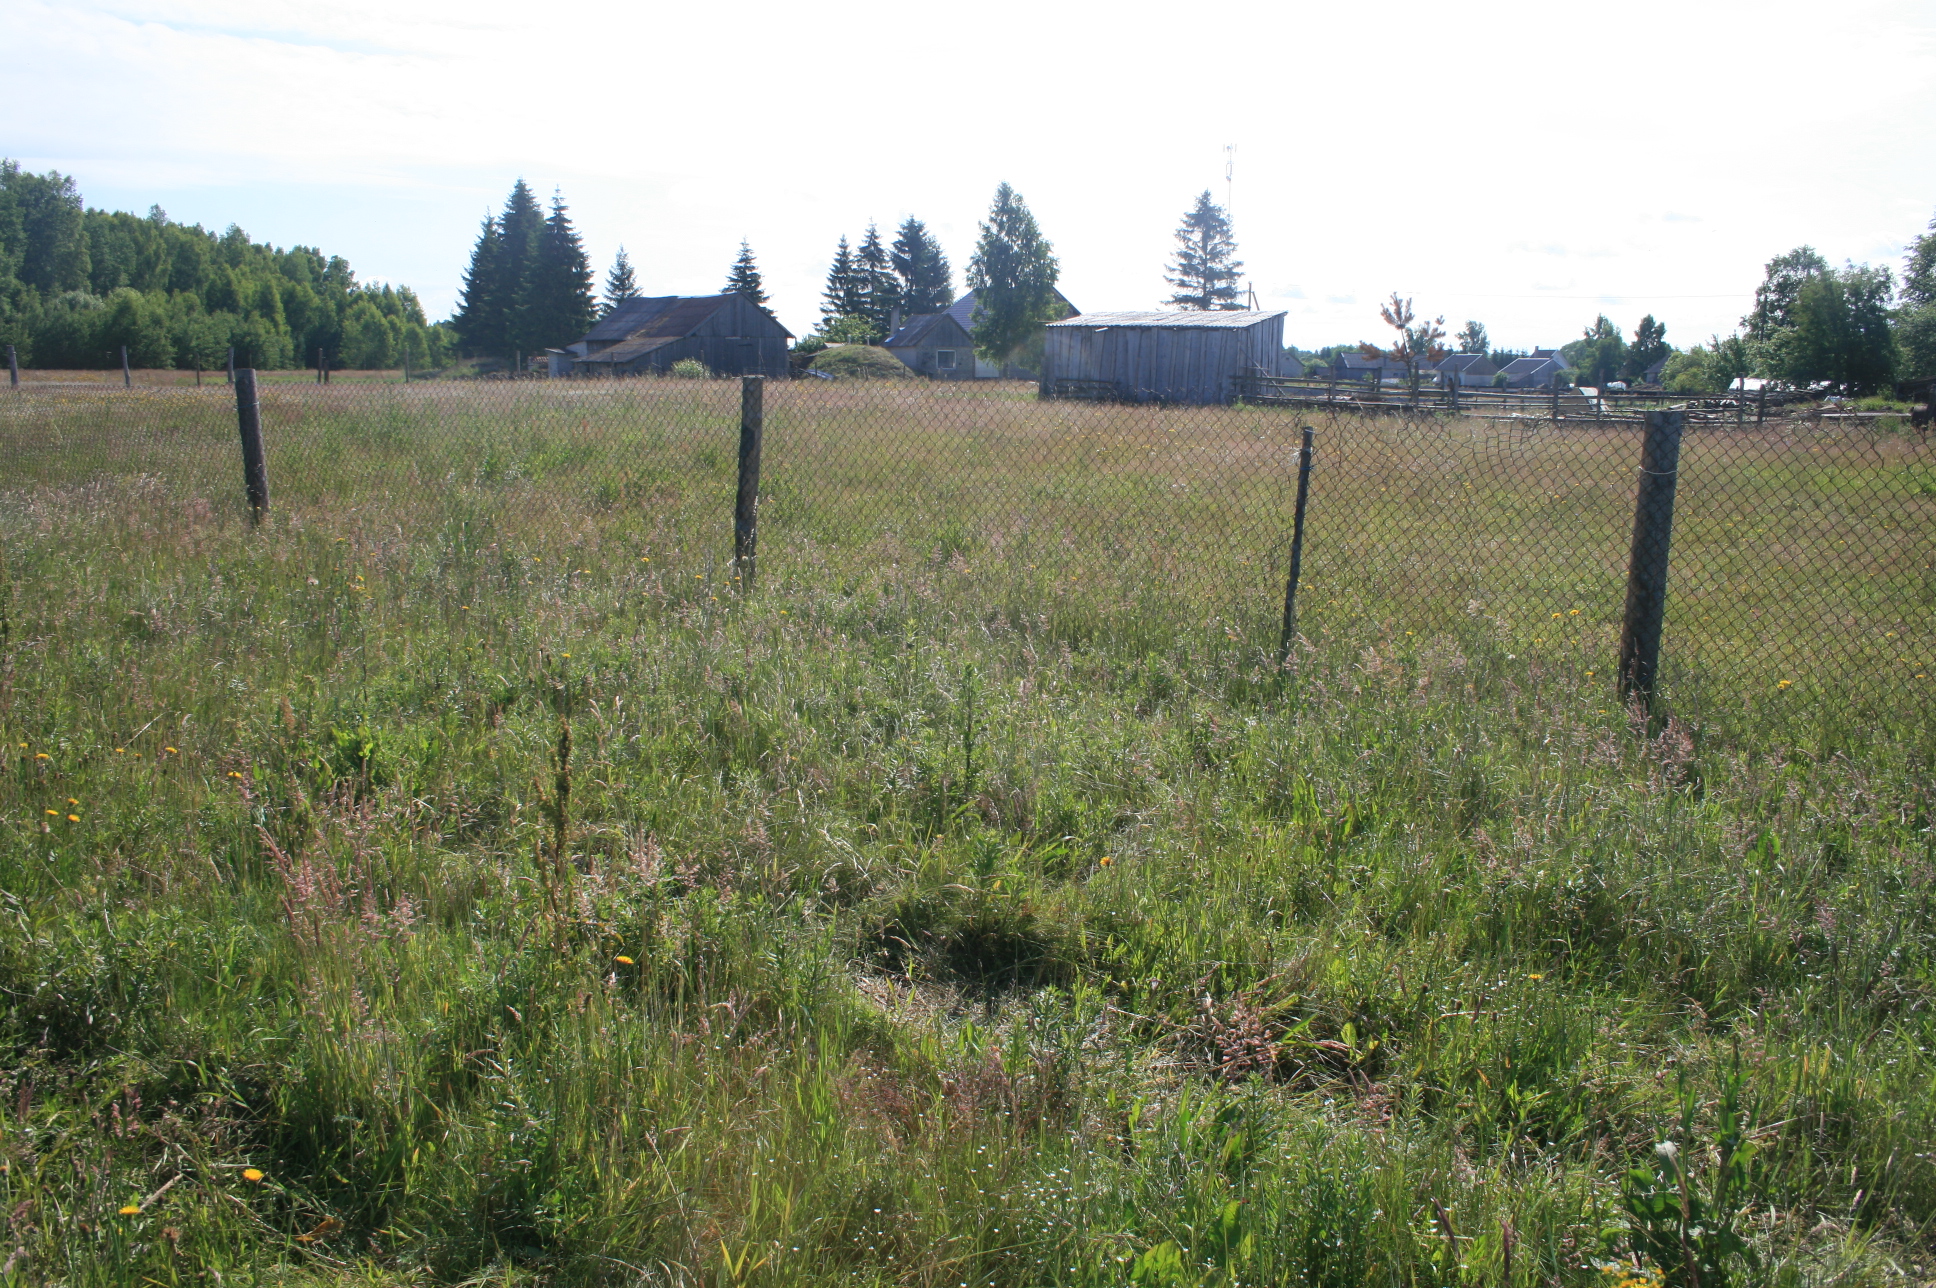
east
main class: Grassland
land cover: Grassland without tree/shrub cover
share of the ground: > 75 %
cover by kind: herbaceous plants 100 %
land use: Agriculture (excluding fallow land and kitchen gardens)
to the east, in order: Grassland without tree/shrub cover; Fences; Grassland without tree/shrub cover; Fences; Grassland without tree/shrub cover; Artificial constructions in urban areas; Grassland without tree/shrub cover; Paved roads, cycling and walking lanes; Single bushes/trees; Grassland without tree/shrub cover
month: June
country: LT
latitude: 55.2320
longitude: 21.7009
